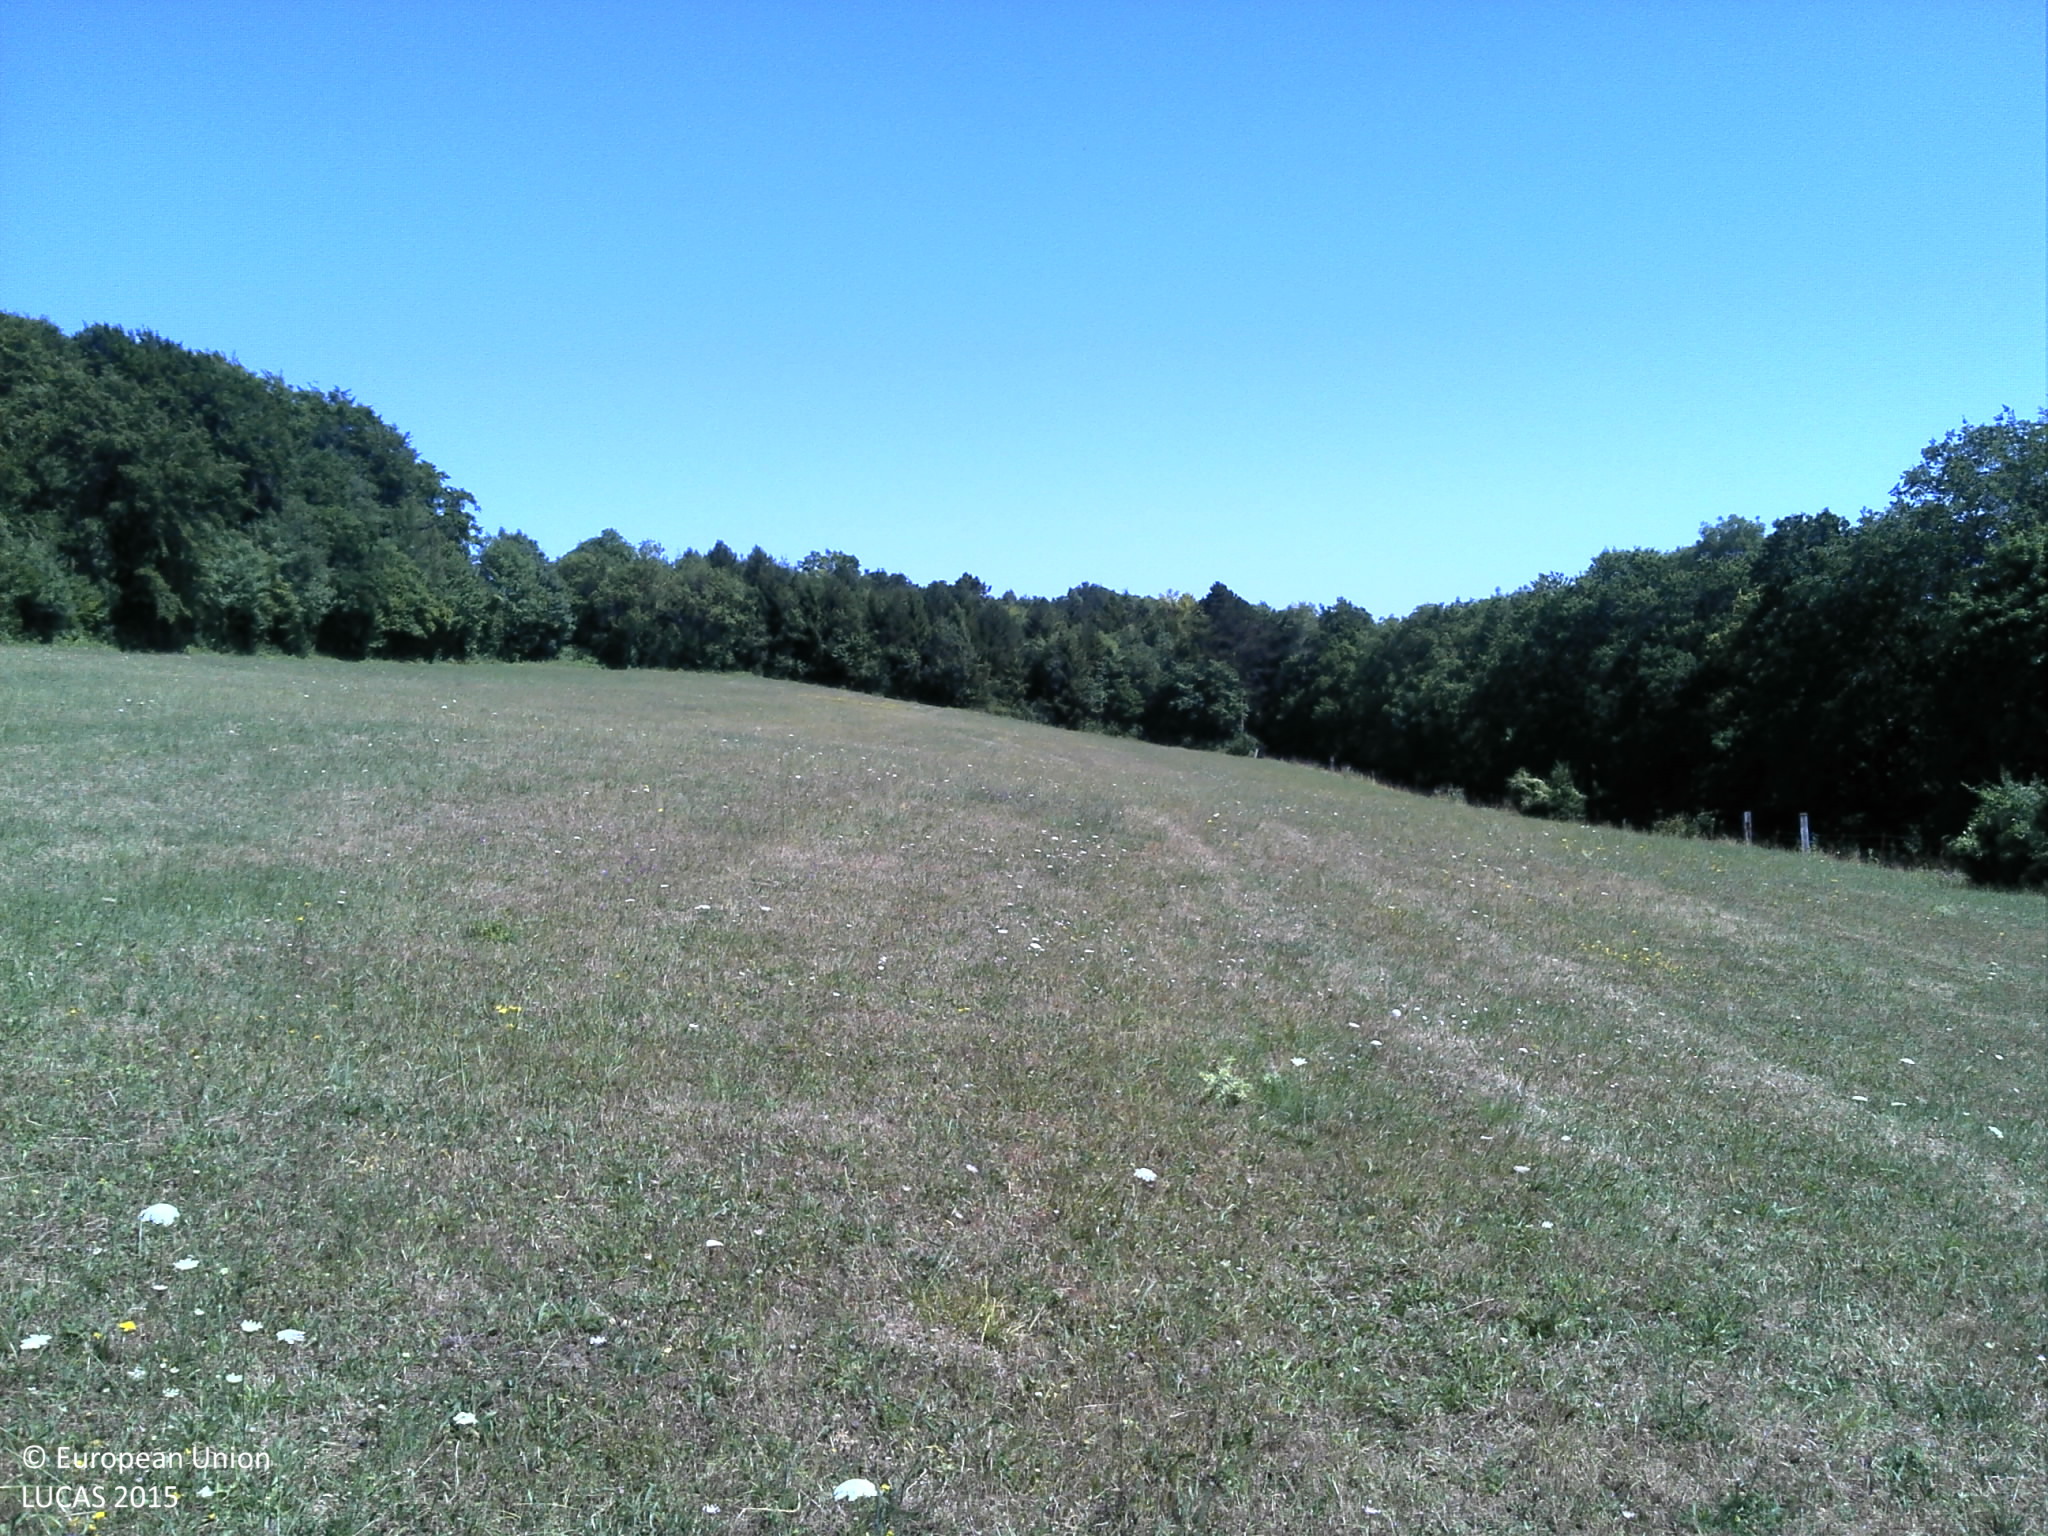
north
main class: Grassland
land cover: Grassland without tree/shrub cover
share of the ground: > 75 %
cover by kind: herbaceous plants 100 %
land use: Agriculture (excluding fallow land and kitchen gardens)
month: July
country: FR
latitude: 49.5884
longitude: 4.6155
